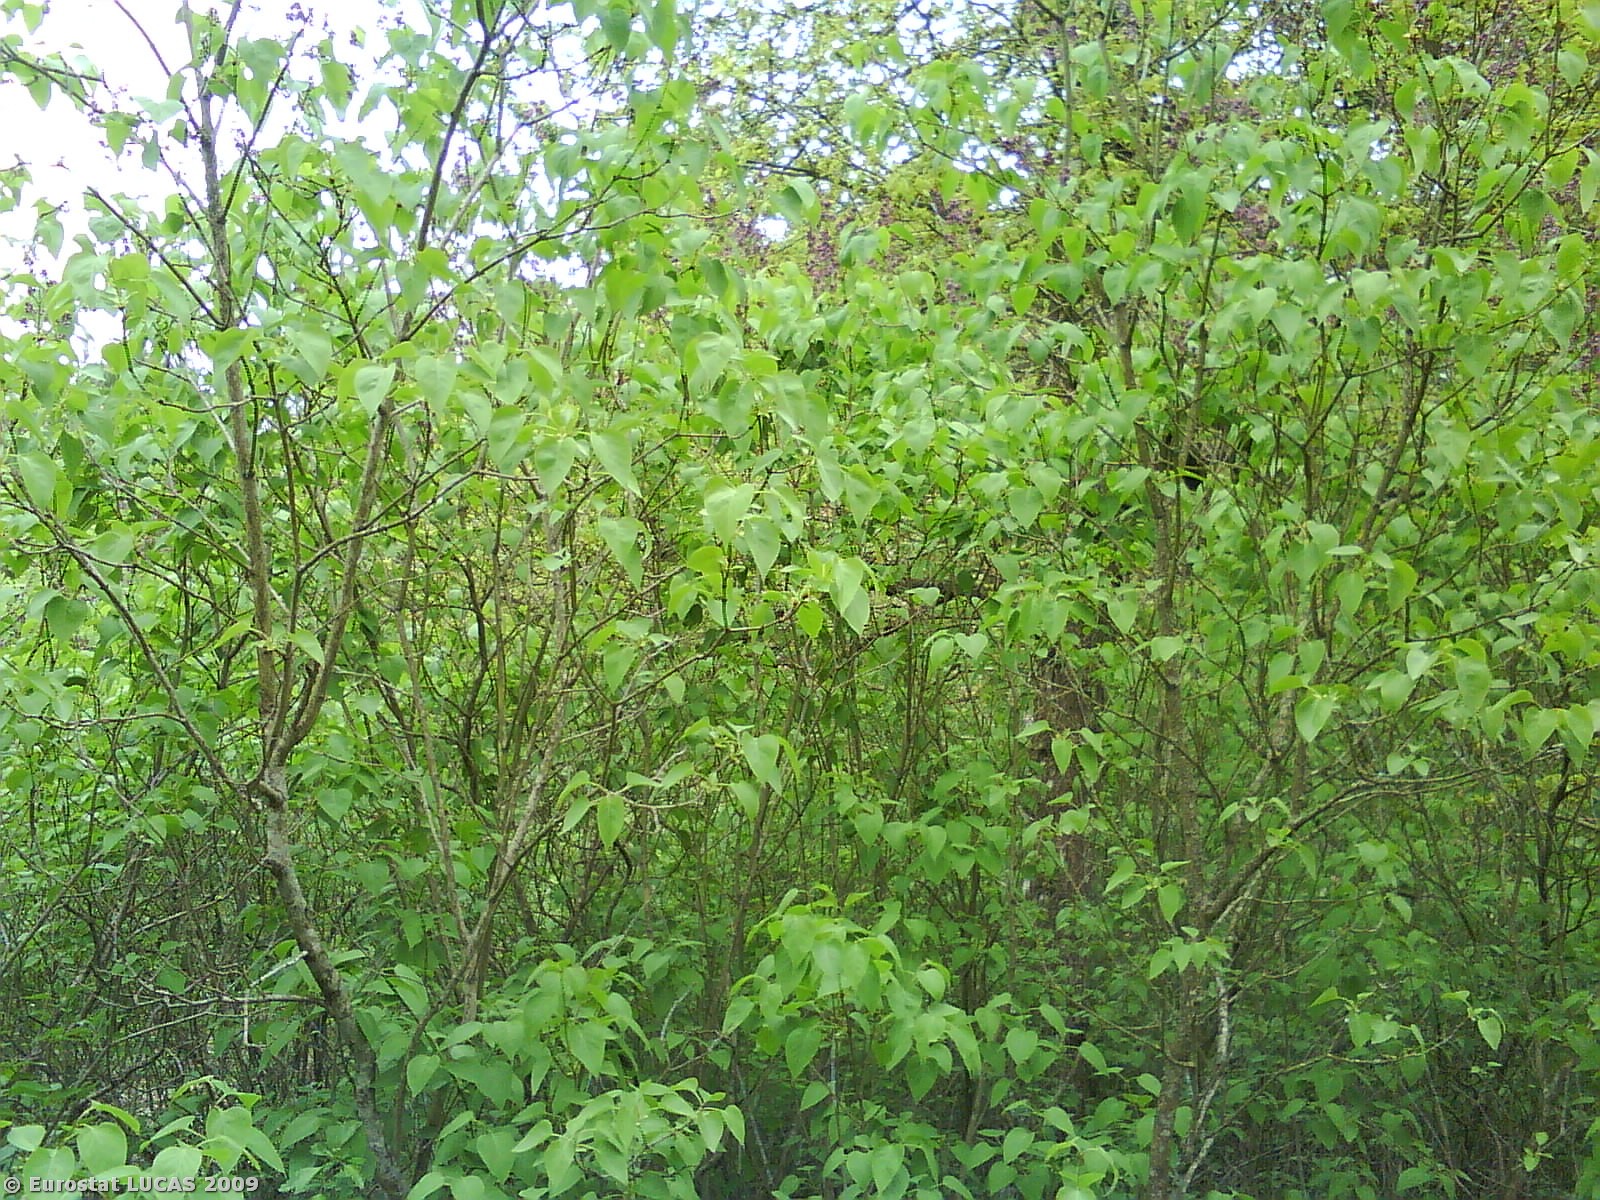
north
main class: Woodland
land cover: Mixed woodland
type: hemiboreal forest and nemoral coniferous forest and mixed broadleaved-coniferous forest
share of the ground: 10 - 25 %
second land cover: Grassland with sparse tree/shrub cover
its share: > 75 %
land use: Forestry
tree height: > 5 m
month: May
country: DK
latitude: 56.4913
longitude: 10.7299
